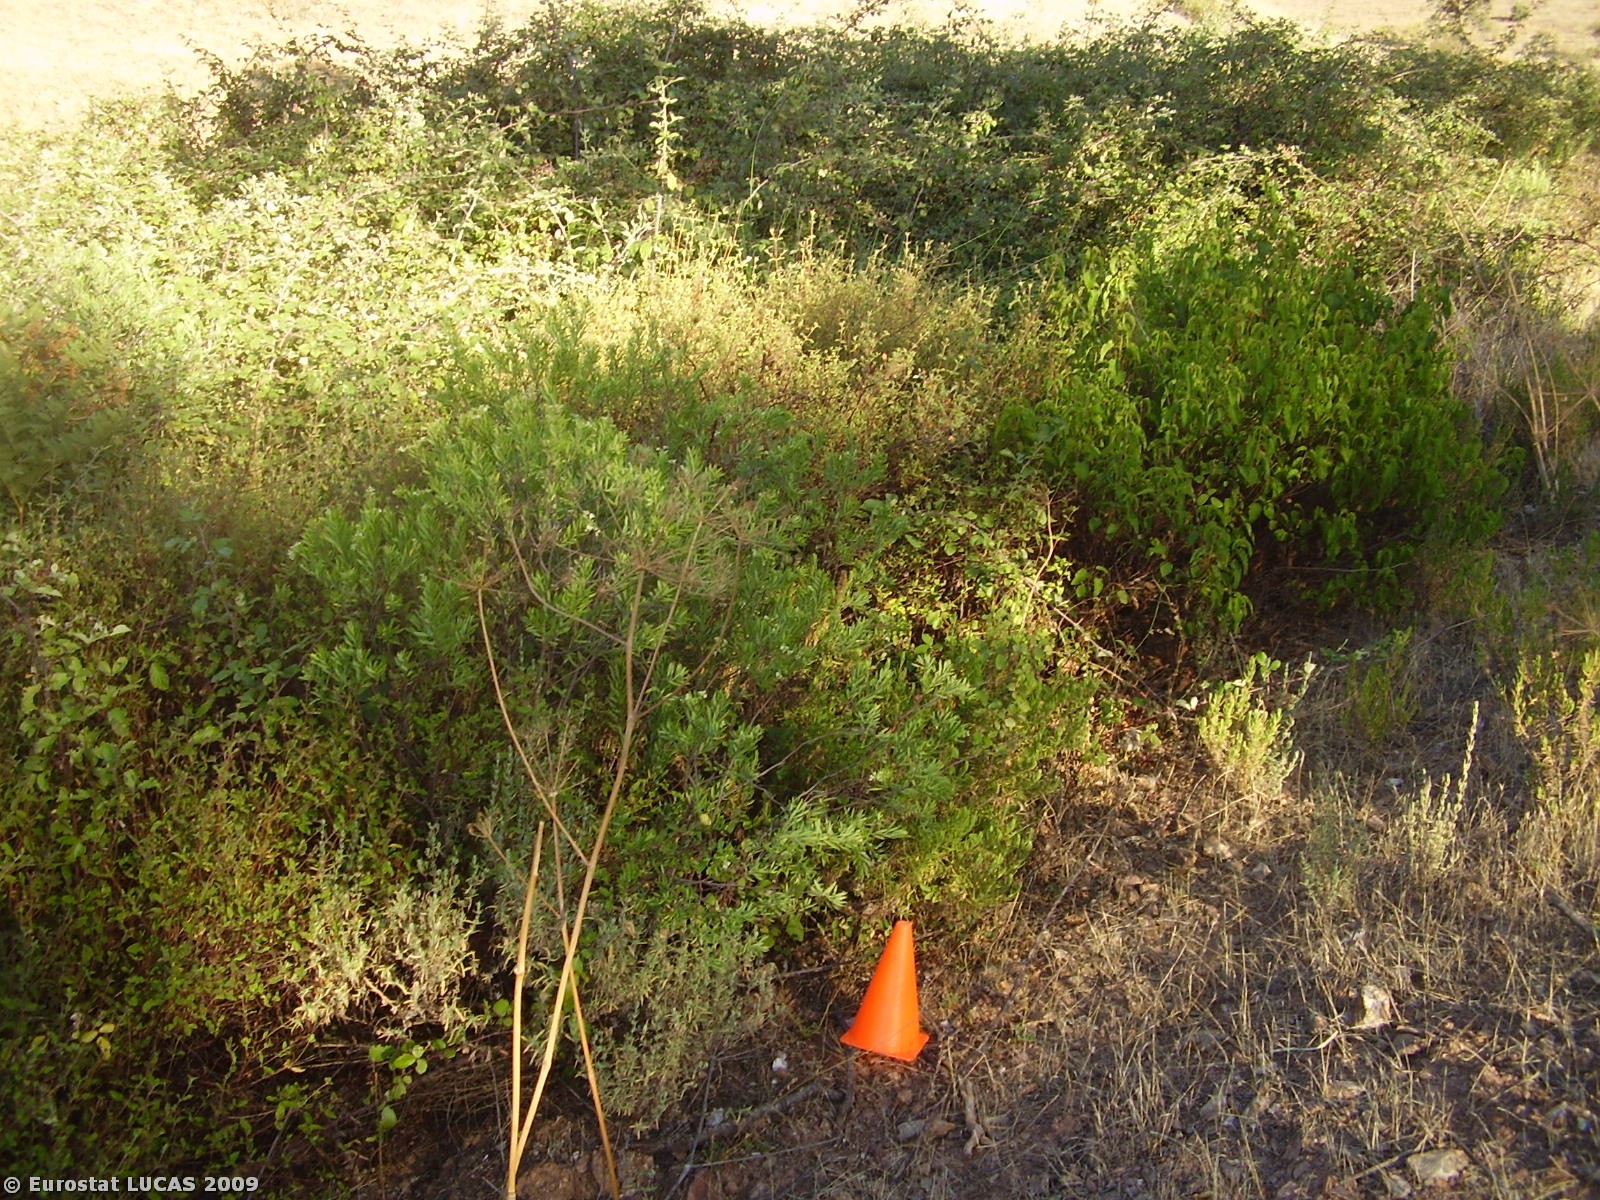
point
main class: Shrubland
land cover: Shrubland without tree cover
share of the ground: > 75 %
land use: Fallow land
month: July
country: PT
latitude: 37.8616
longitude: -7.5331
